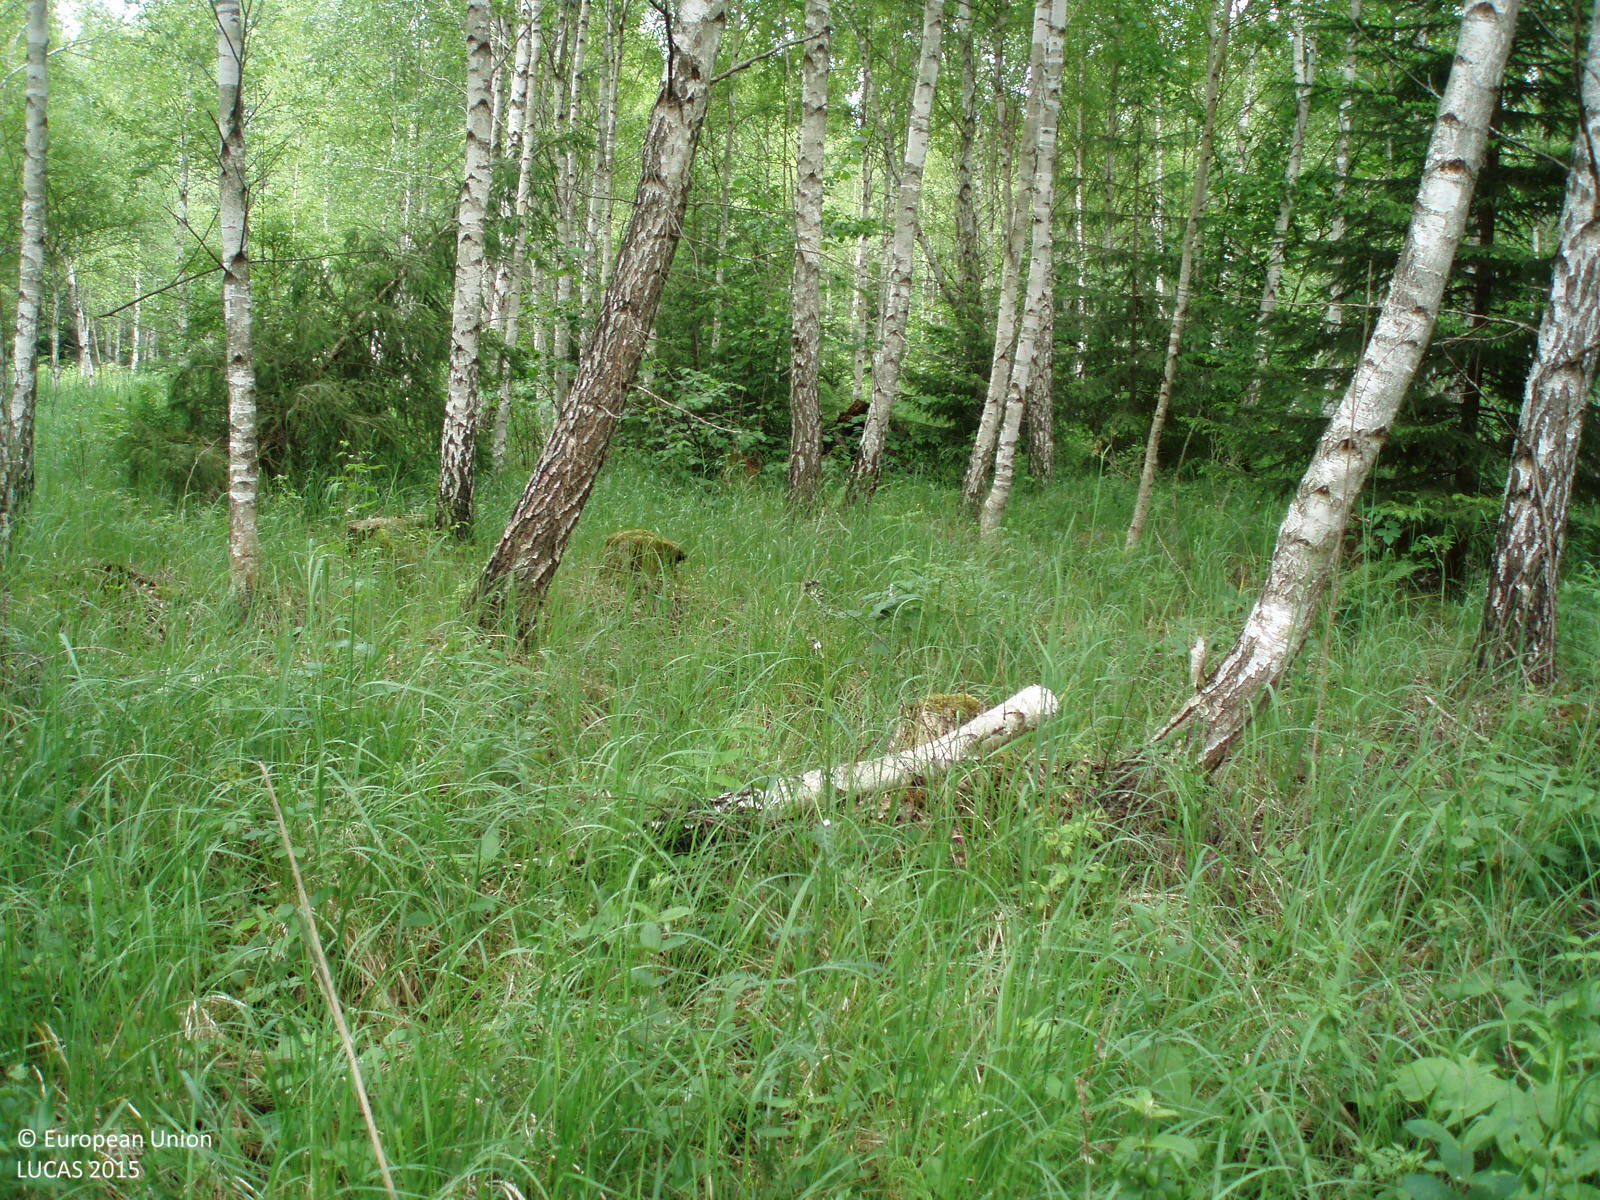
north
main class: Woodland
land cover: Broadleaved woodland
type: acidophilous oak and oak-birch forest
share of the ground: 50 - 75 %
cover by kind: broadleaved forest trees 65 %, herbaceous plants 30 %, coniferous forest trees 5 %
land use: Forestry
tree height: > 5 m
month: June
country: LT
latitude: 56.2176
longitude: 22.9833
